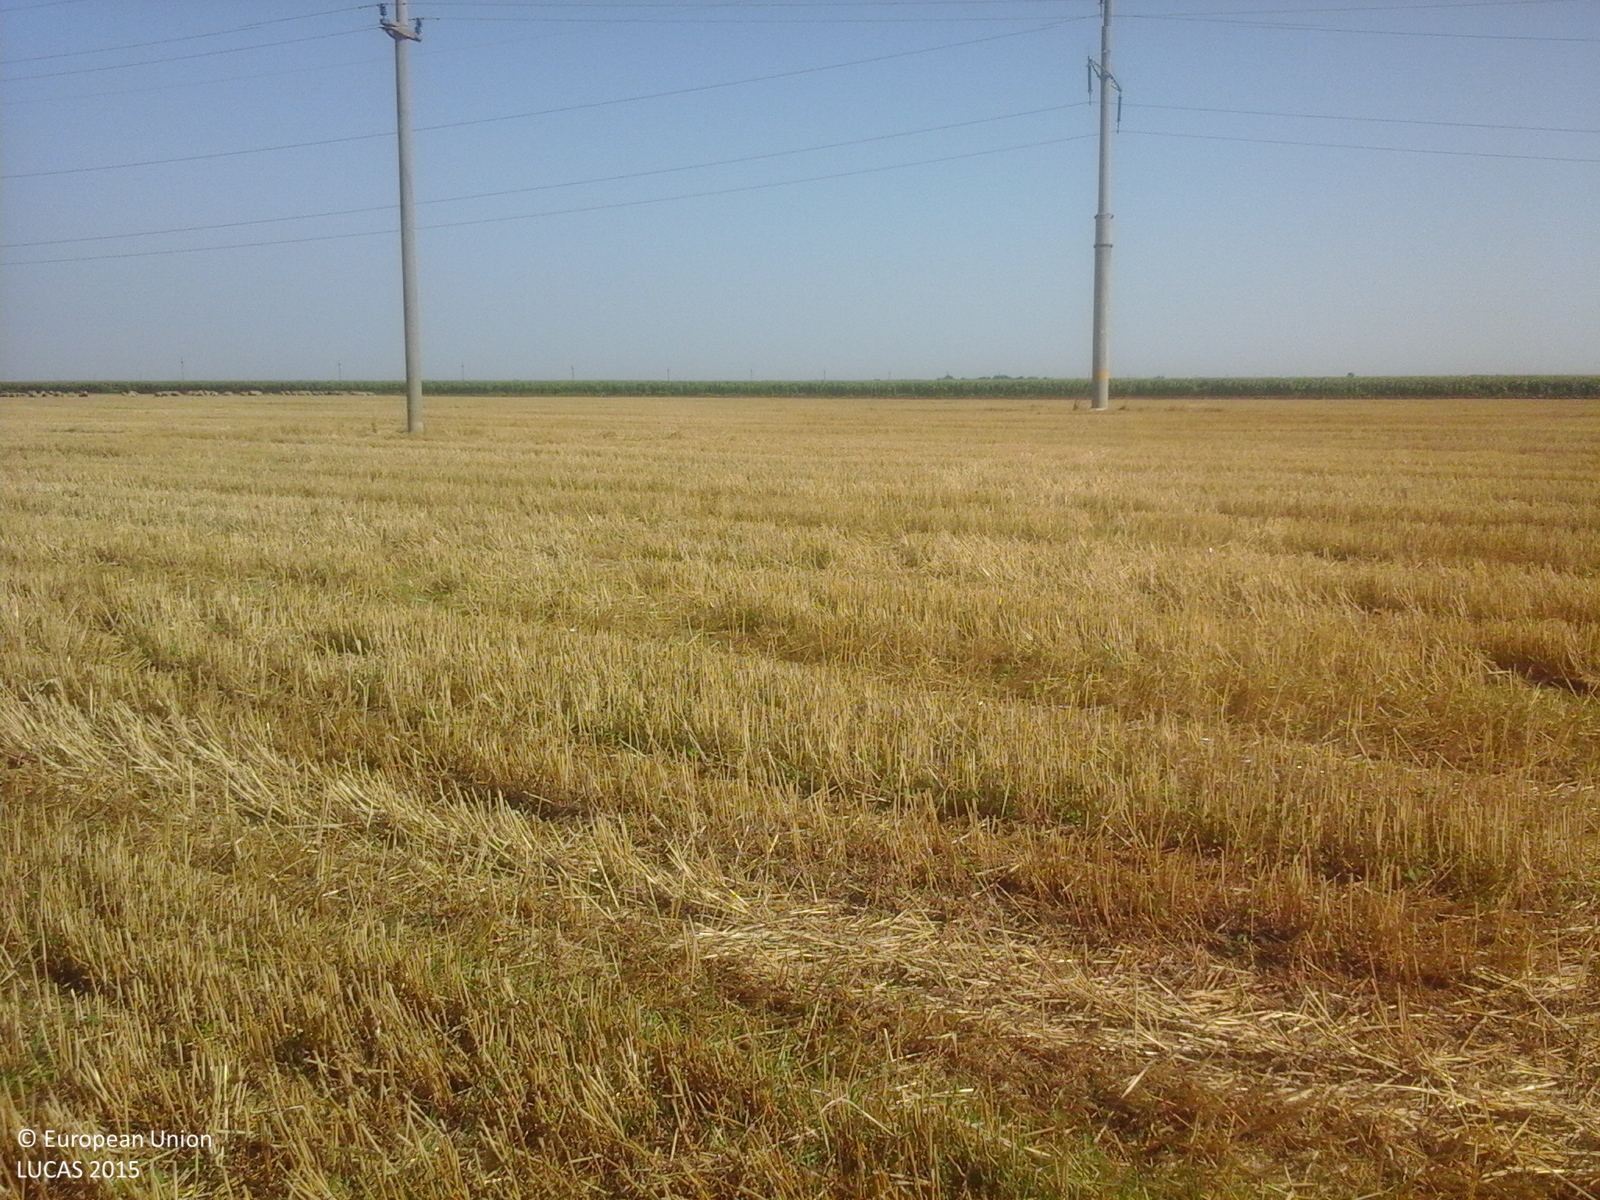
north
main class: Cropland
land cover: Durum wheat
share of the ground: > 75 %
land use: Agriculture (excluding fallow land and kitchen gardens)
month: July
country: RO
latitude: 44.4540
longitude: 27.1612
